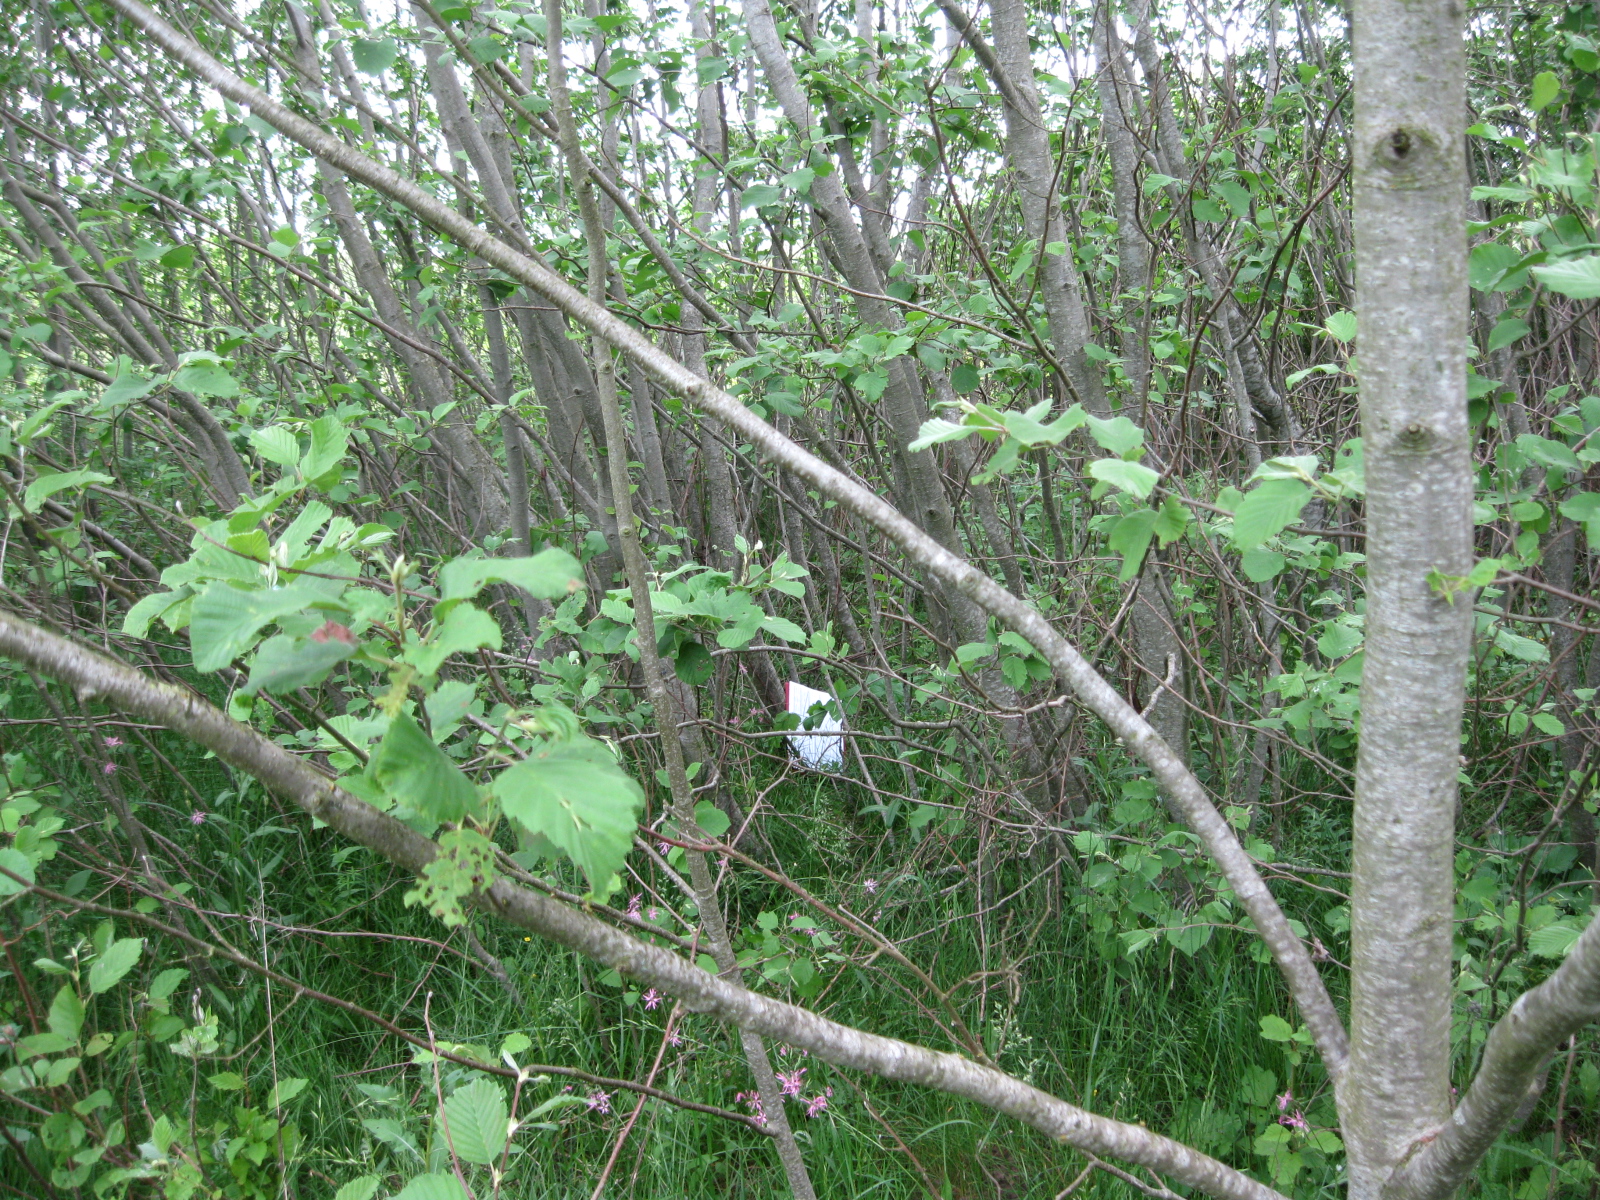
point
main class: Woodland
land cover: Broadleaved woodland
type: floodplain forest
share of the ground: 50 - 75 %
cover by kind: broadleaved forest trees 65 %, herbaceous plants 25 %, shrubs 10 %
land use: Semi-natural and natural areas not in use
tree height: > 5 m
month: June
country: LT
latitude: 55.3214
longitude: 23.5228
